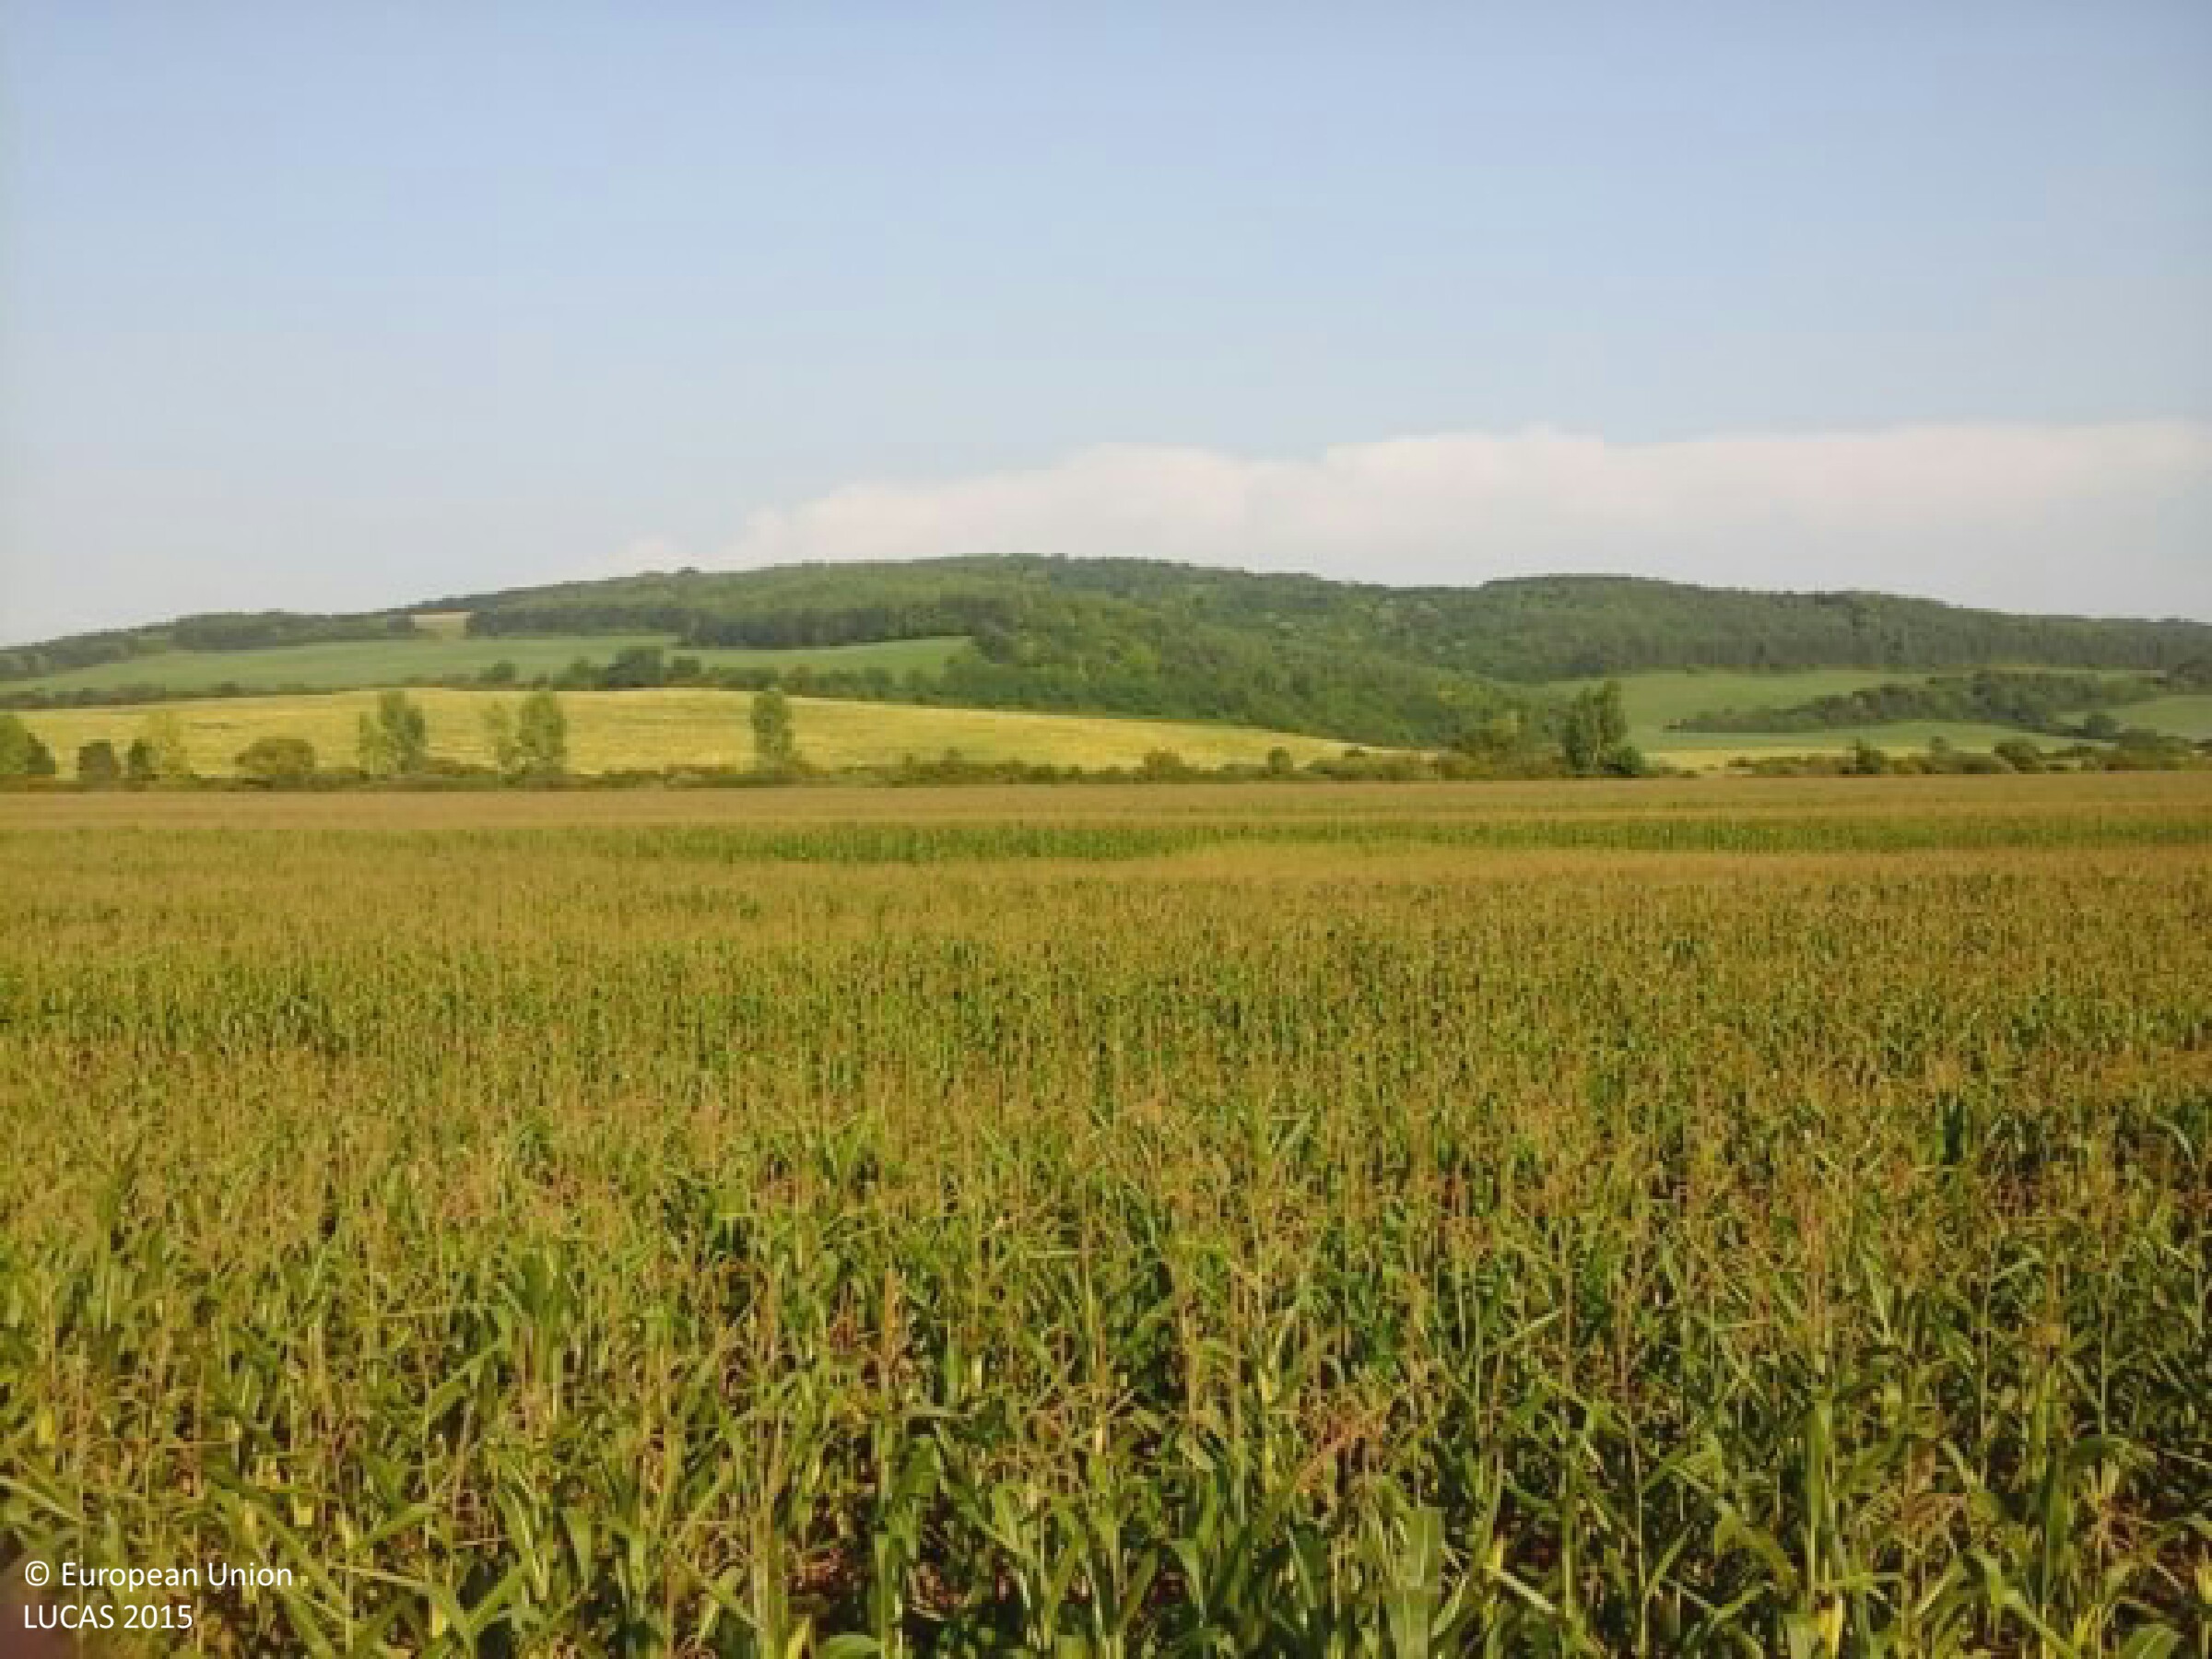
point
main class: Cropland
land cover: Maize
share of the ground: > 75 %
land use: Agriculture (excluding fallow land and kitchen gardens)
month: August
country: HU
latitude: 46.2776
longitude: 18.1182
